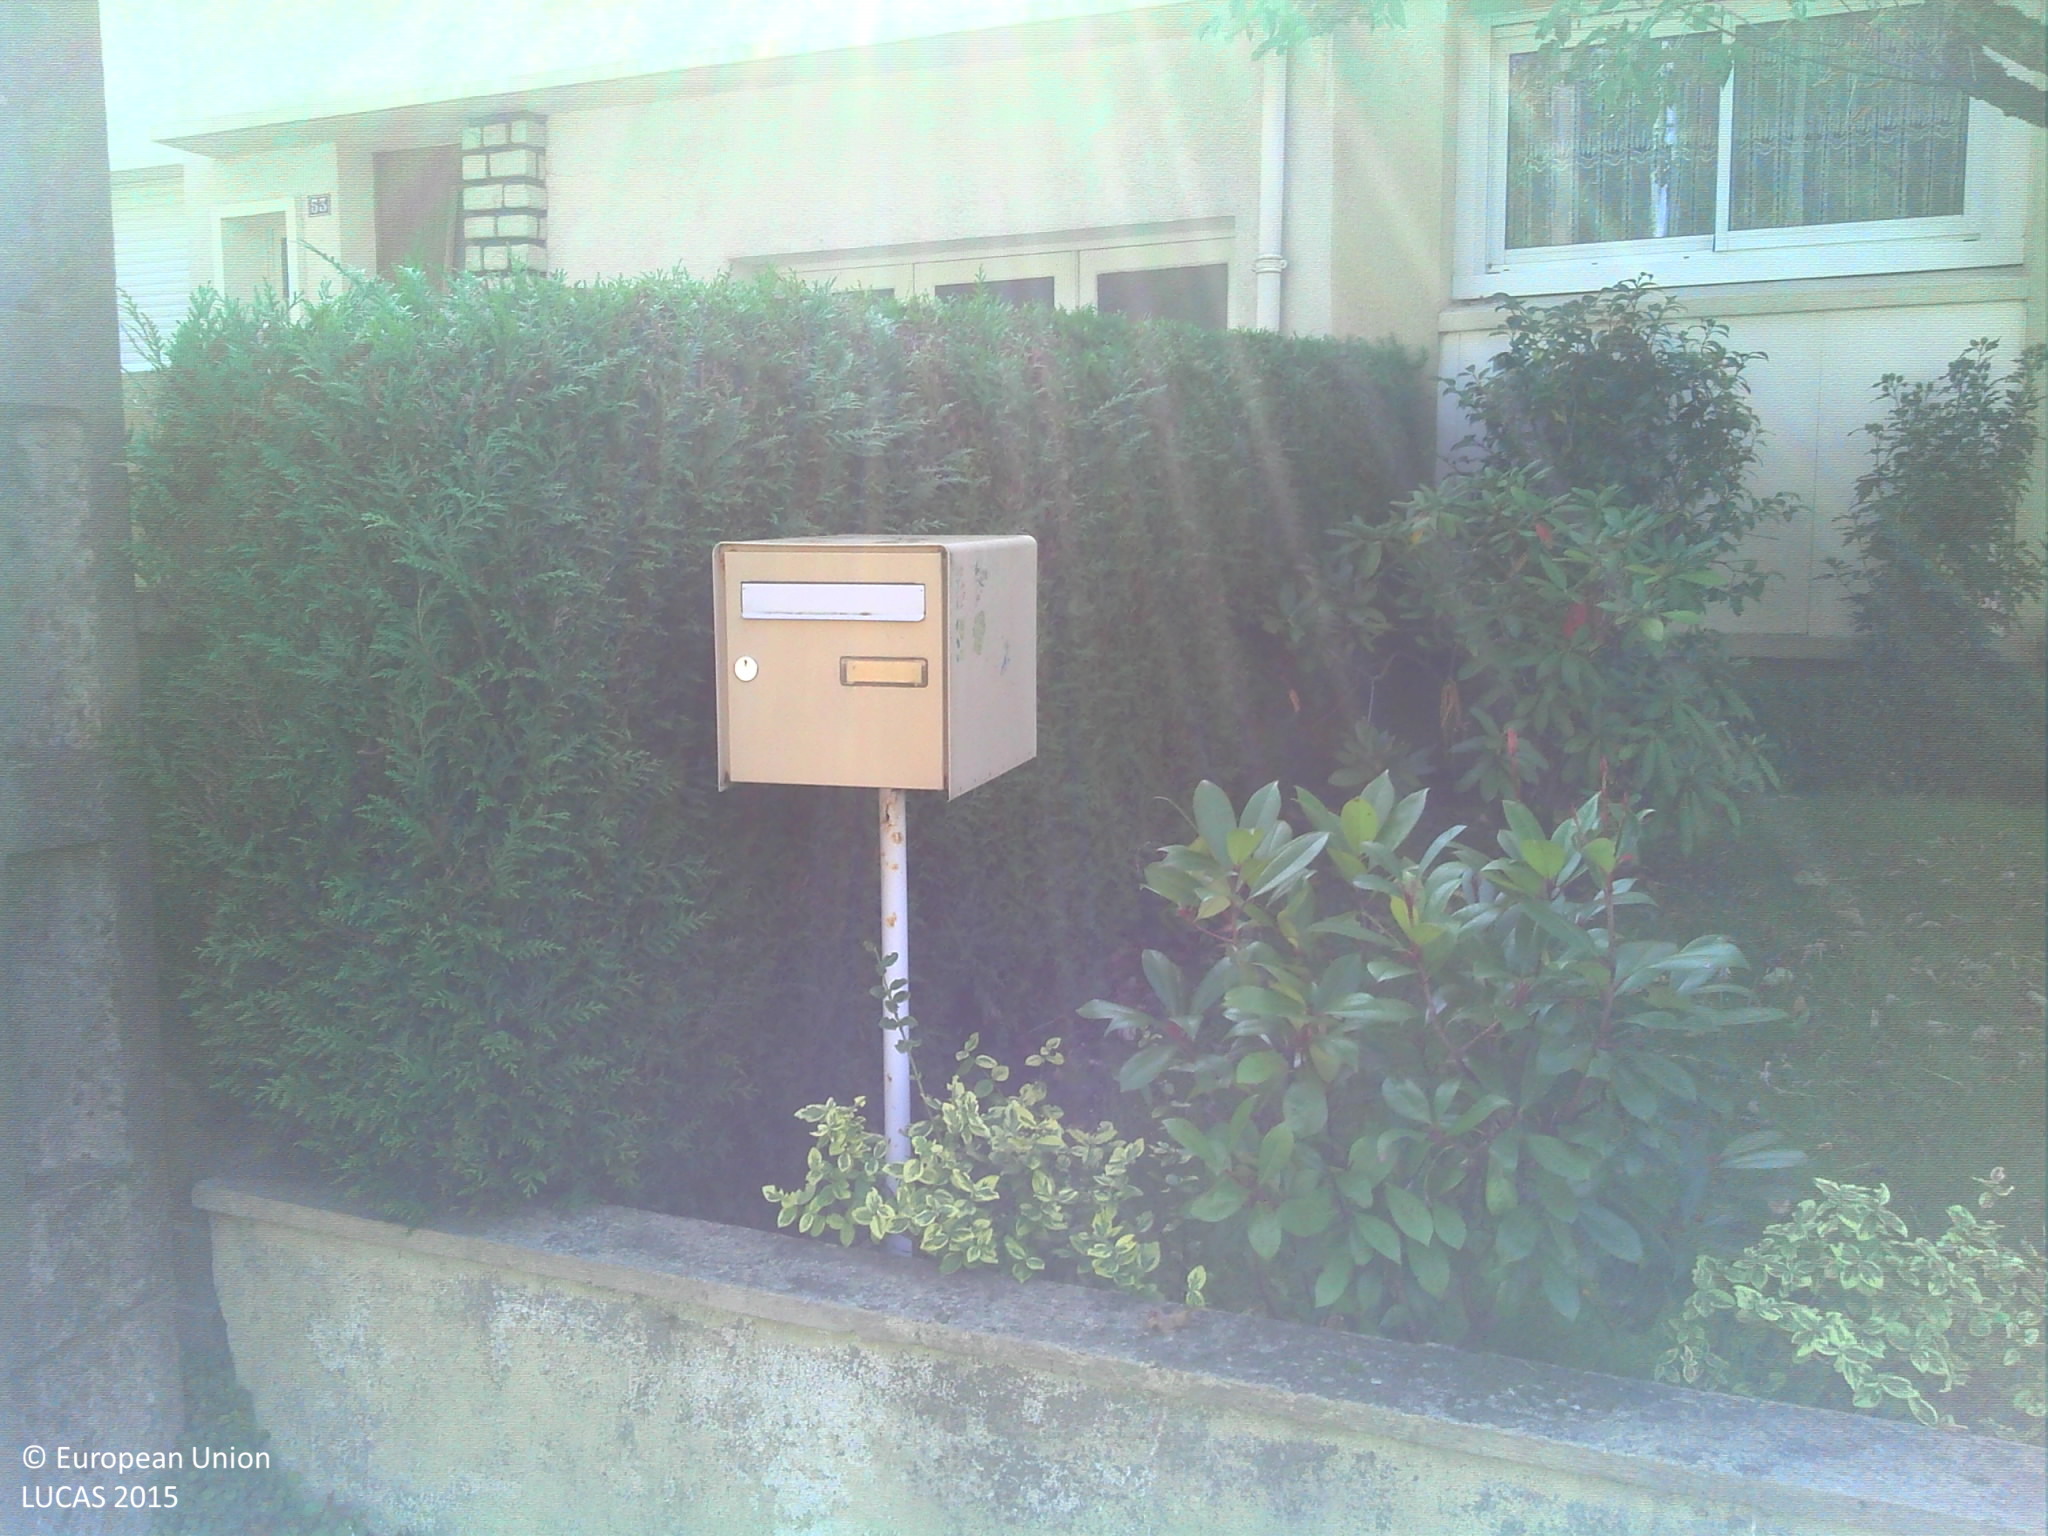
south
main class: Woodland
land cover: Other mixed woodland
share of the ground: > 75 %
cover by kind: coniferous forest trees 65 %, broadleaved forest trees 25 %, herbaceous plants 10 %
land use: Residential
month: October
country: FR
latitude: 47.0644
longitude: -0.8961
